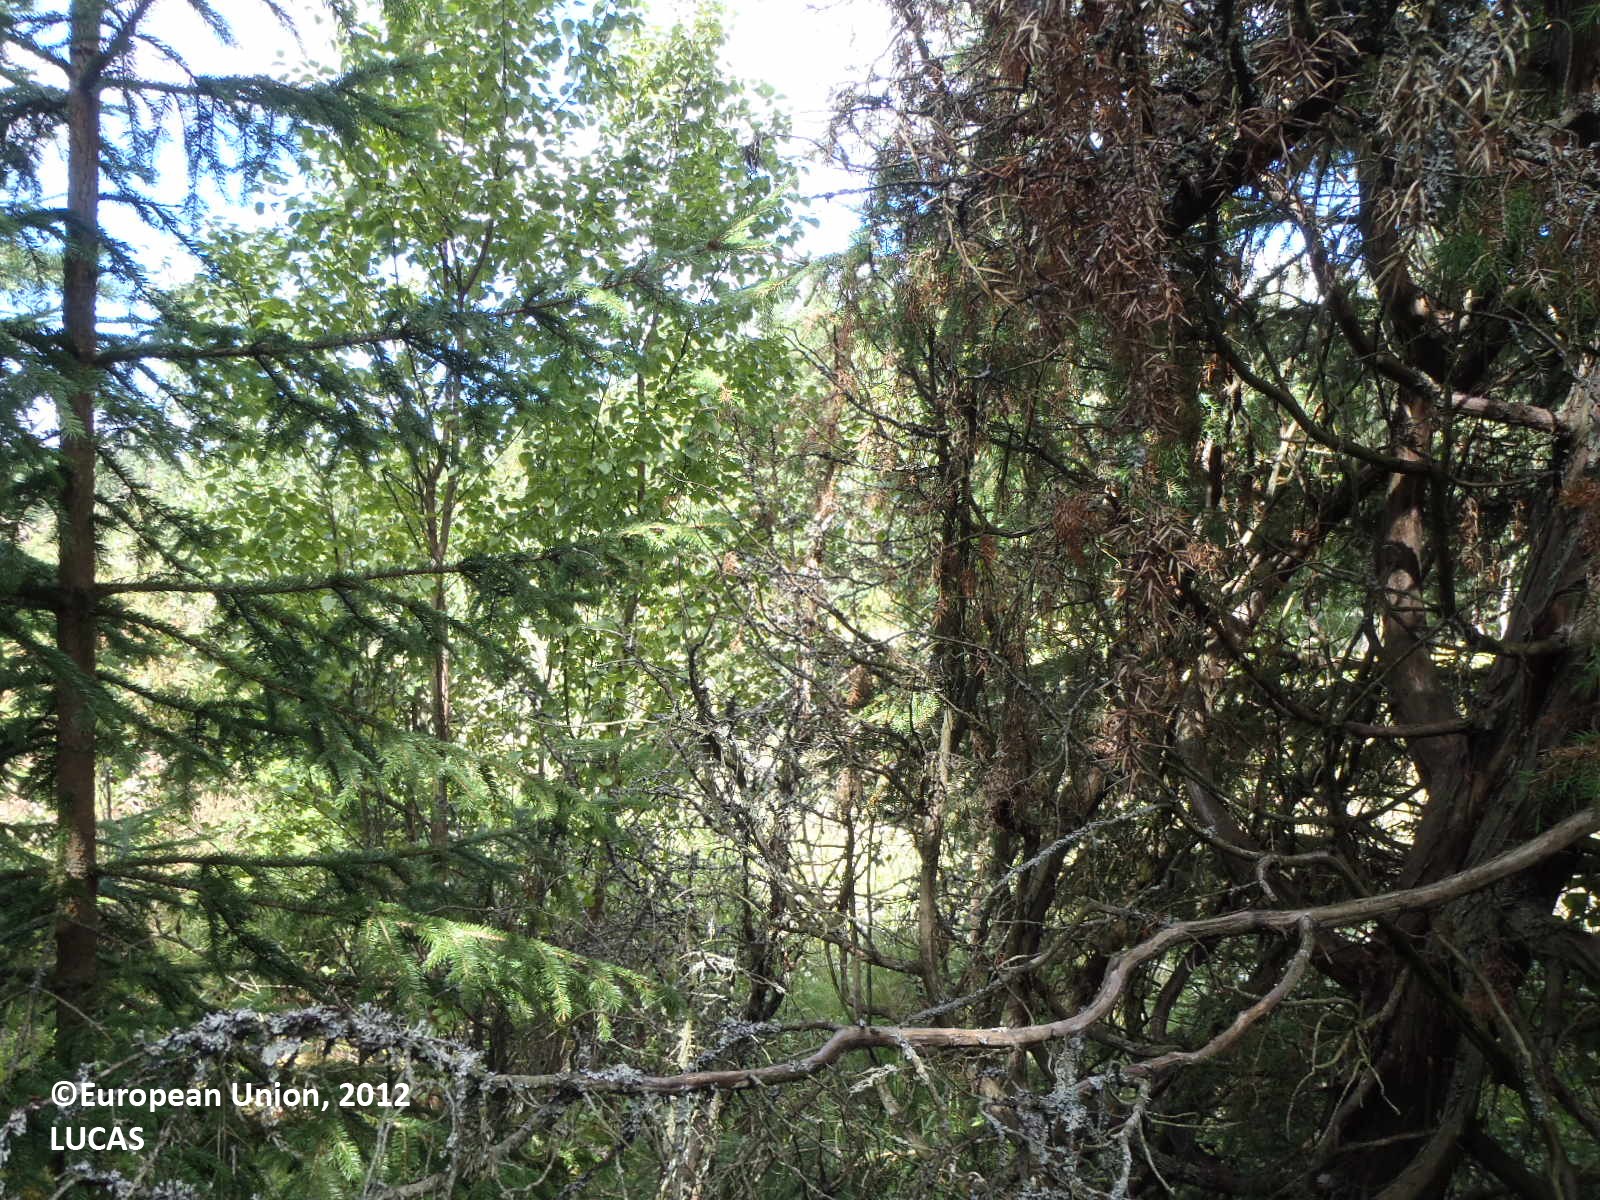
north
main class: Woodland
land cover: Spruce dominated mixed woodland
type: boreal forest
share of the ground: > 75 %
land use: Forestry
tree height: > 5 m
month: August
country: FI
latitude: 60.1224
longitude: 21.9972
